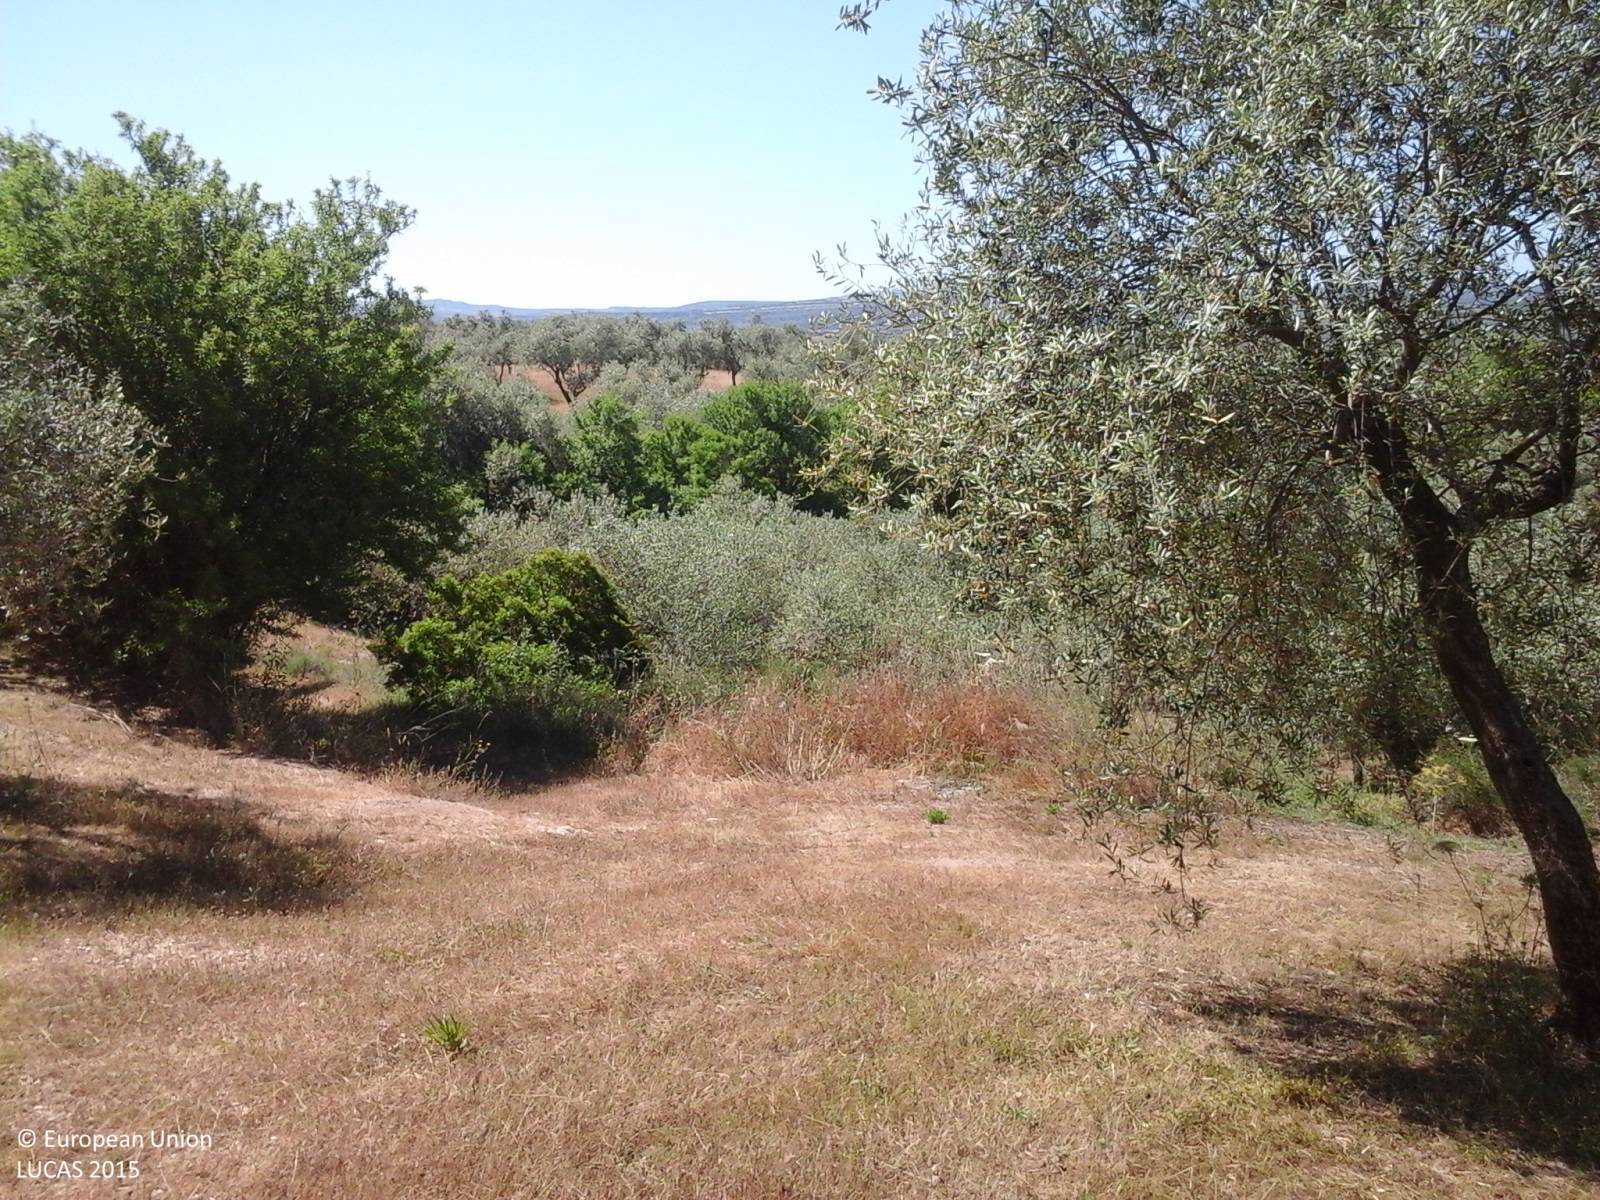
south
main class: Cropland
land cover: Olive groves
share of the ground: 25 - 50 %
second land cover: Spontaneously vegetated surfaces
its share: 50 - 75 %
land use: Agriculture (excluding fallow land and kitchen gardens)
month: May
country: IT
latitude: 40.6538
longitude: 8.4817
